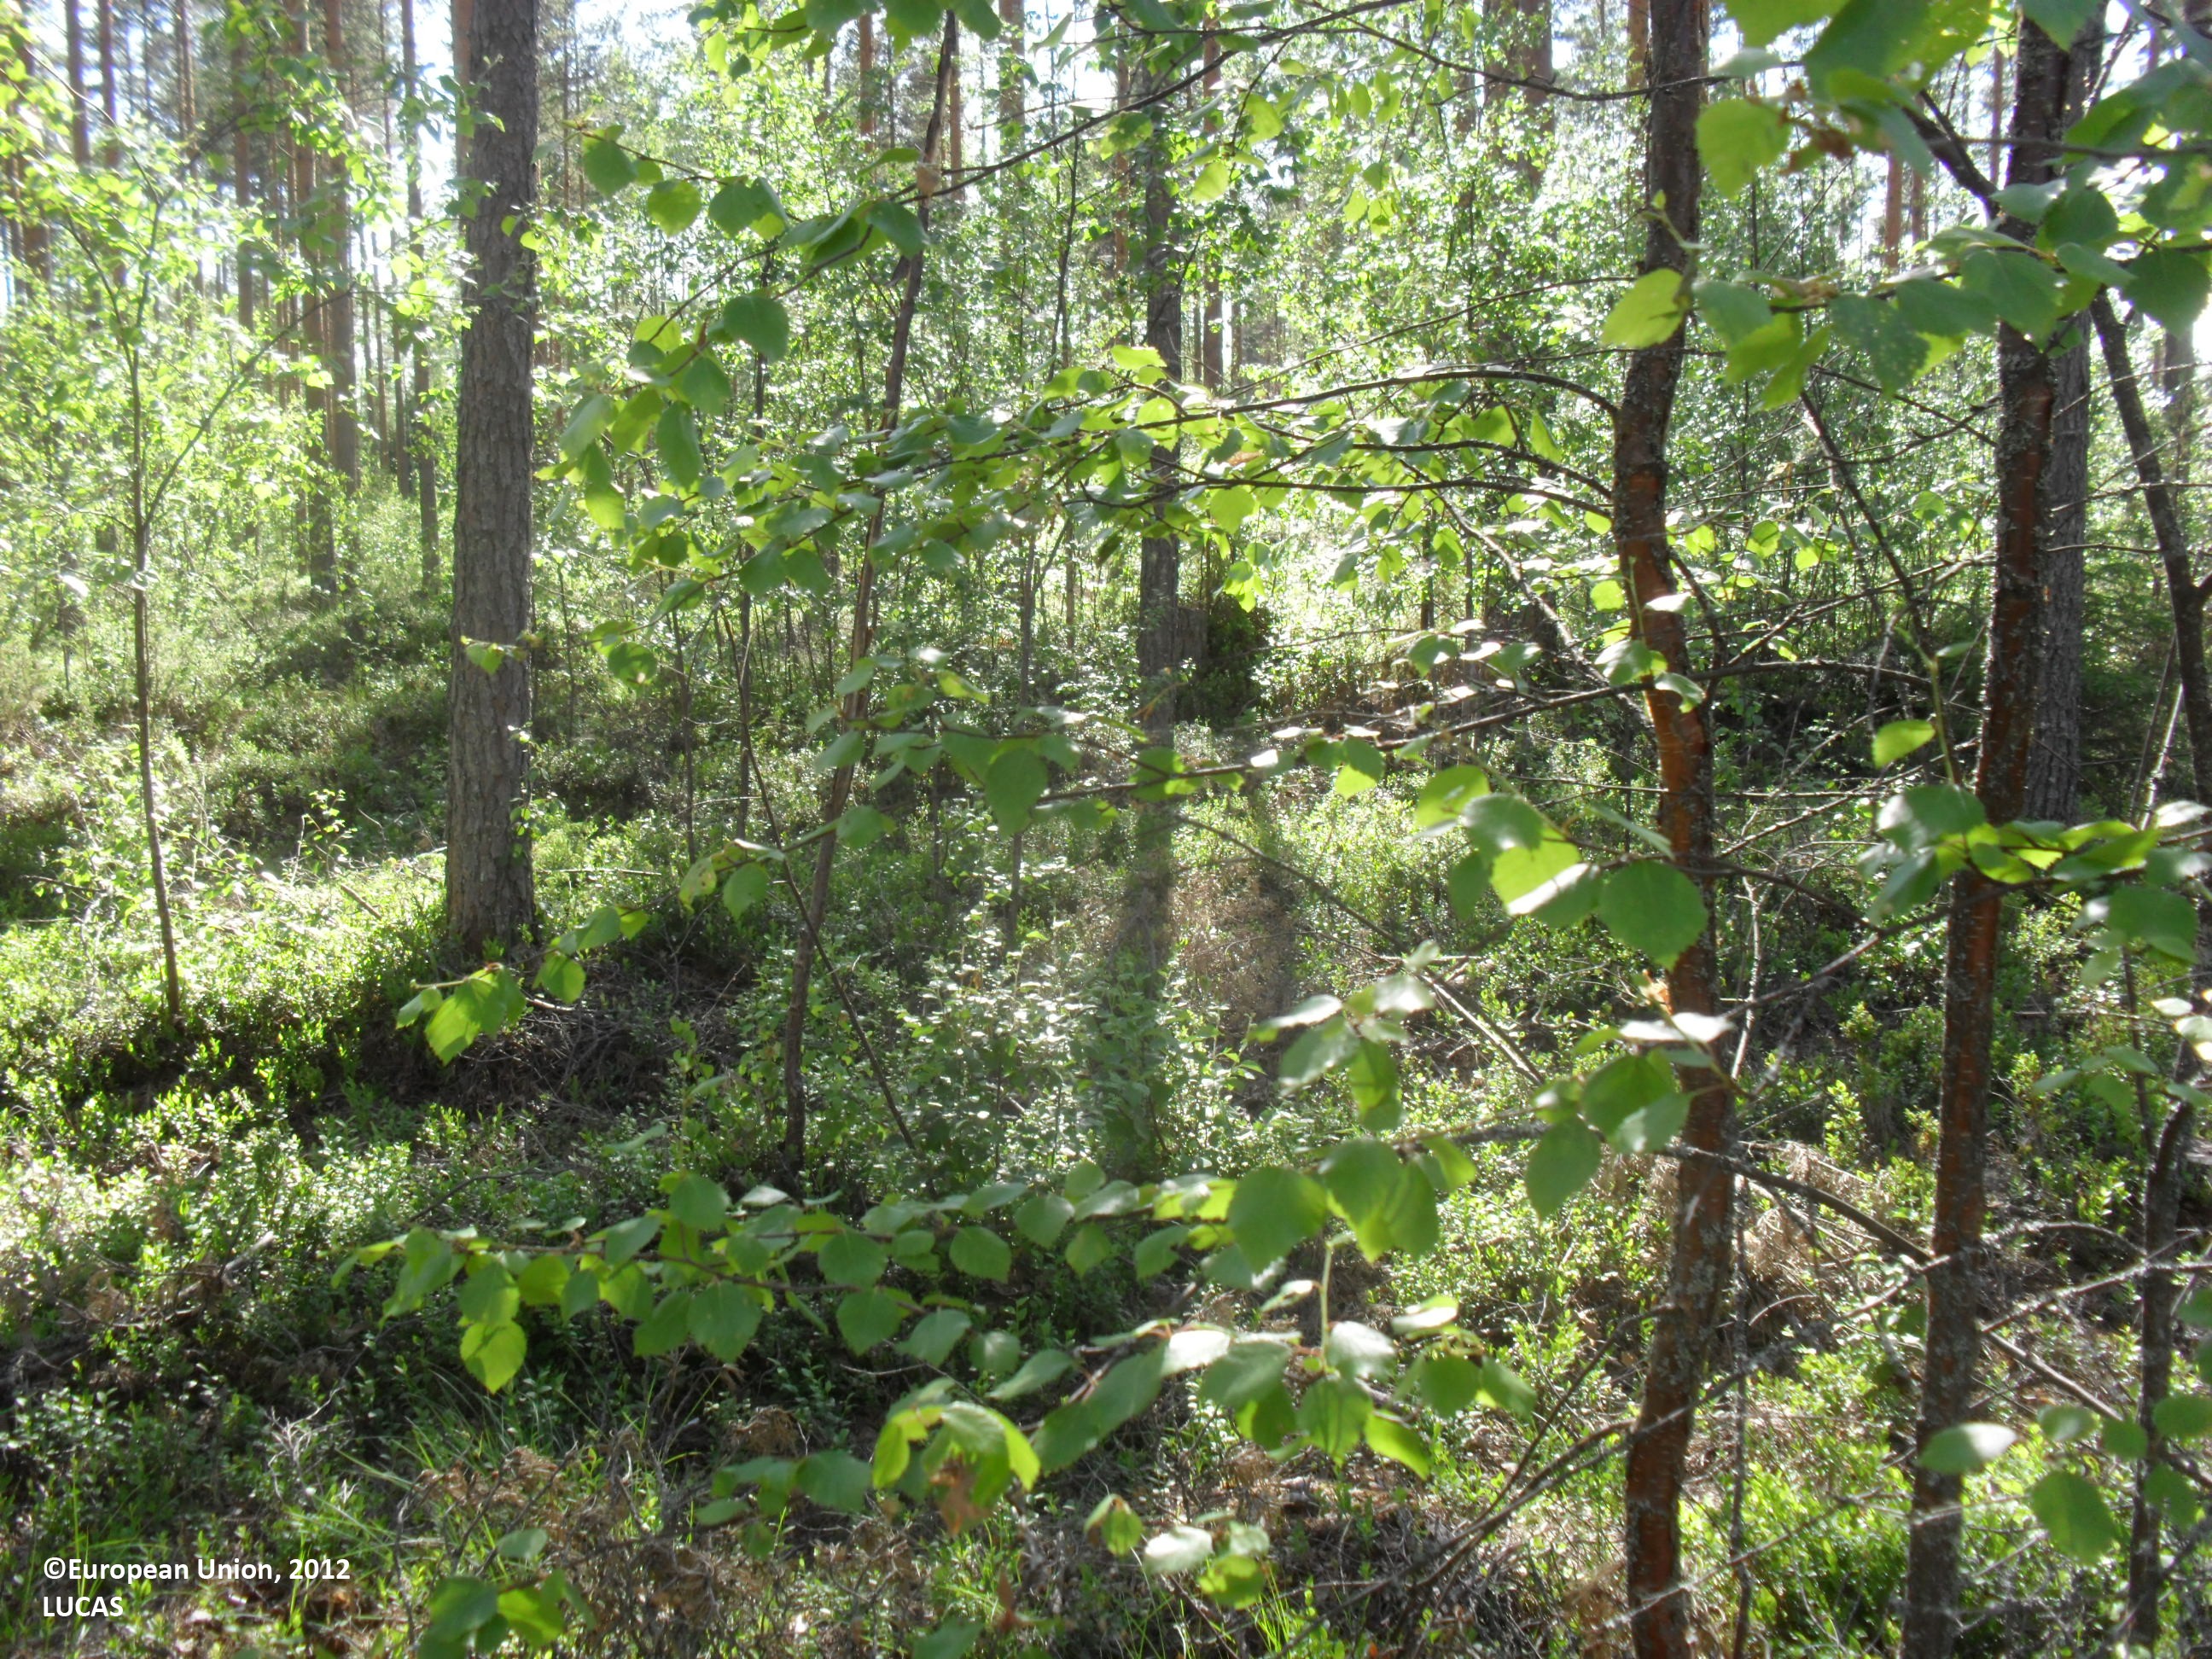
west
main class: Woodland
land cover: Pine dominated mixed woodland
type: boreal forest
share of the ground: 50 - 75 %
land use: Forestry
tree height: > 5 m
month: June
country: FI
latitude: 62.9665
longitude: 23.7778
